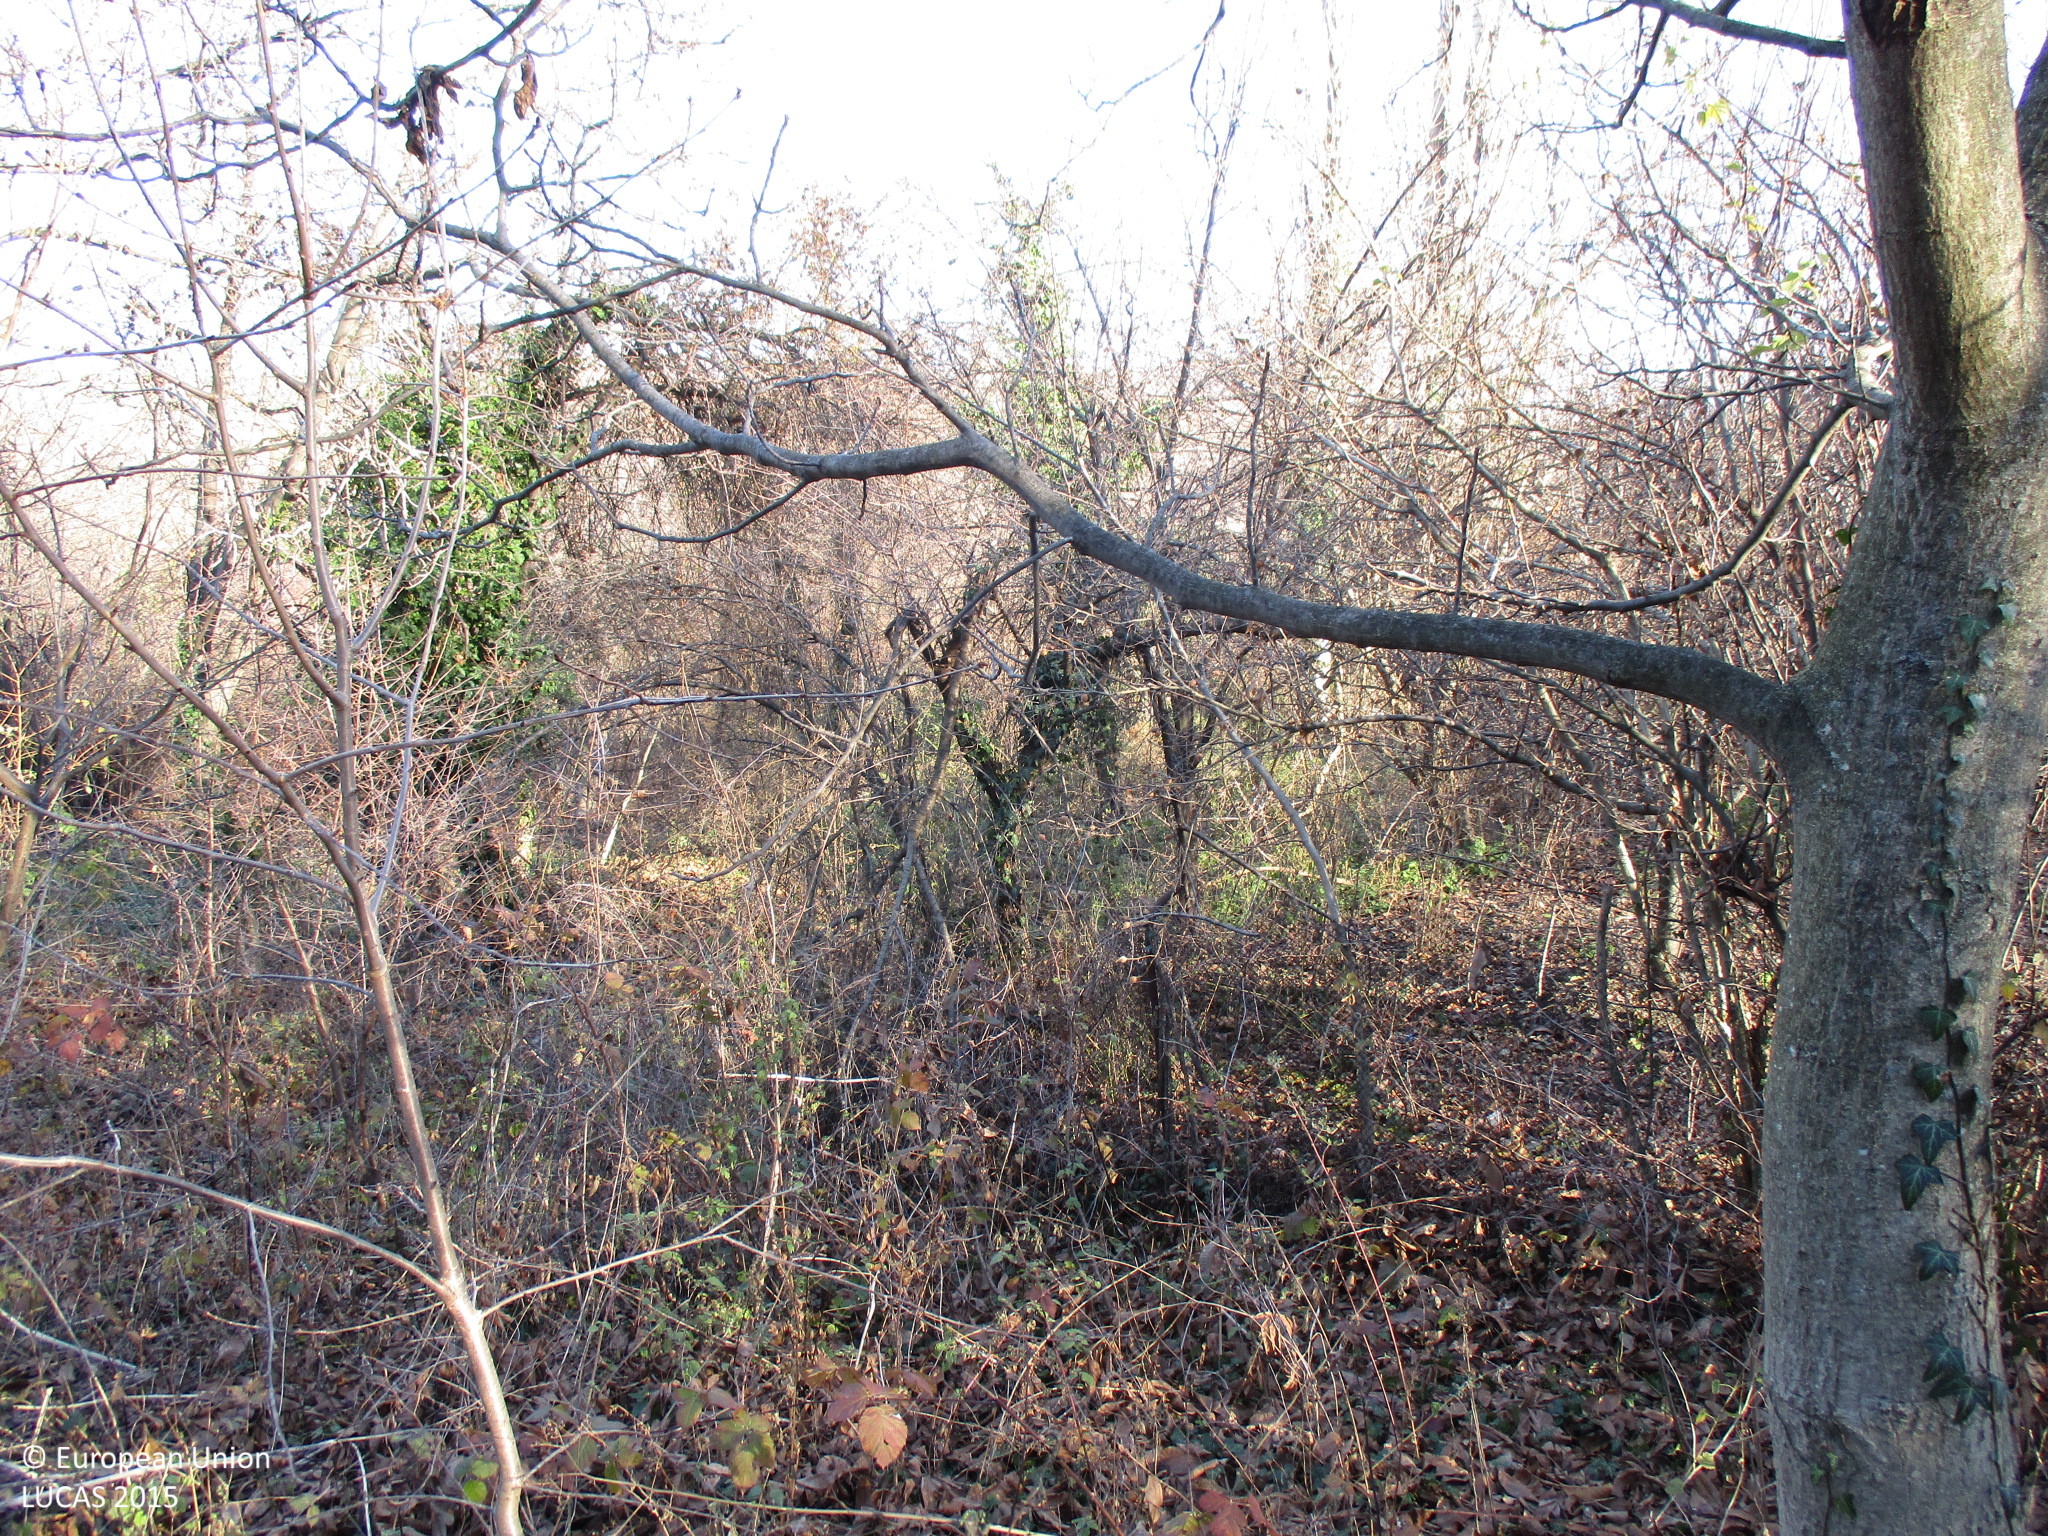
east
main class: Woodland
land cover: Broadleaved woodland
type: mesophytic deciduous forest
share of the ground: > 75 %
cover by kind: broadleaved forest trees 90 %, shrubs 10 %
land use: Semi-natural and natural areas not in use
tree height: > 5 m
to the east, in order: Broadleaved woodland; Rivers and streams; Broadleaved woodland; Shrubland without tree cover; Grassland without tree/shrub cover; Abandoned hedges; Grassland without tree/shrub cover; Abandoned hedges; Grassland without tree/shrub cover; Broadleaved woodland; Tracks; Broadleaved woodland
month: December
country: BG
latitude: 42.0363
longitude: 24.6774
